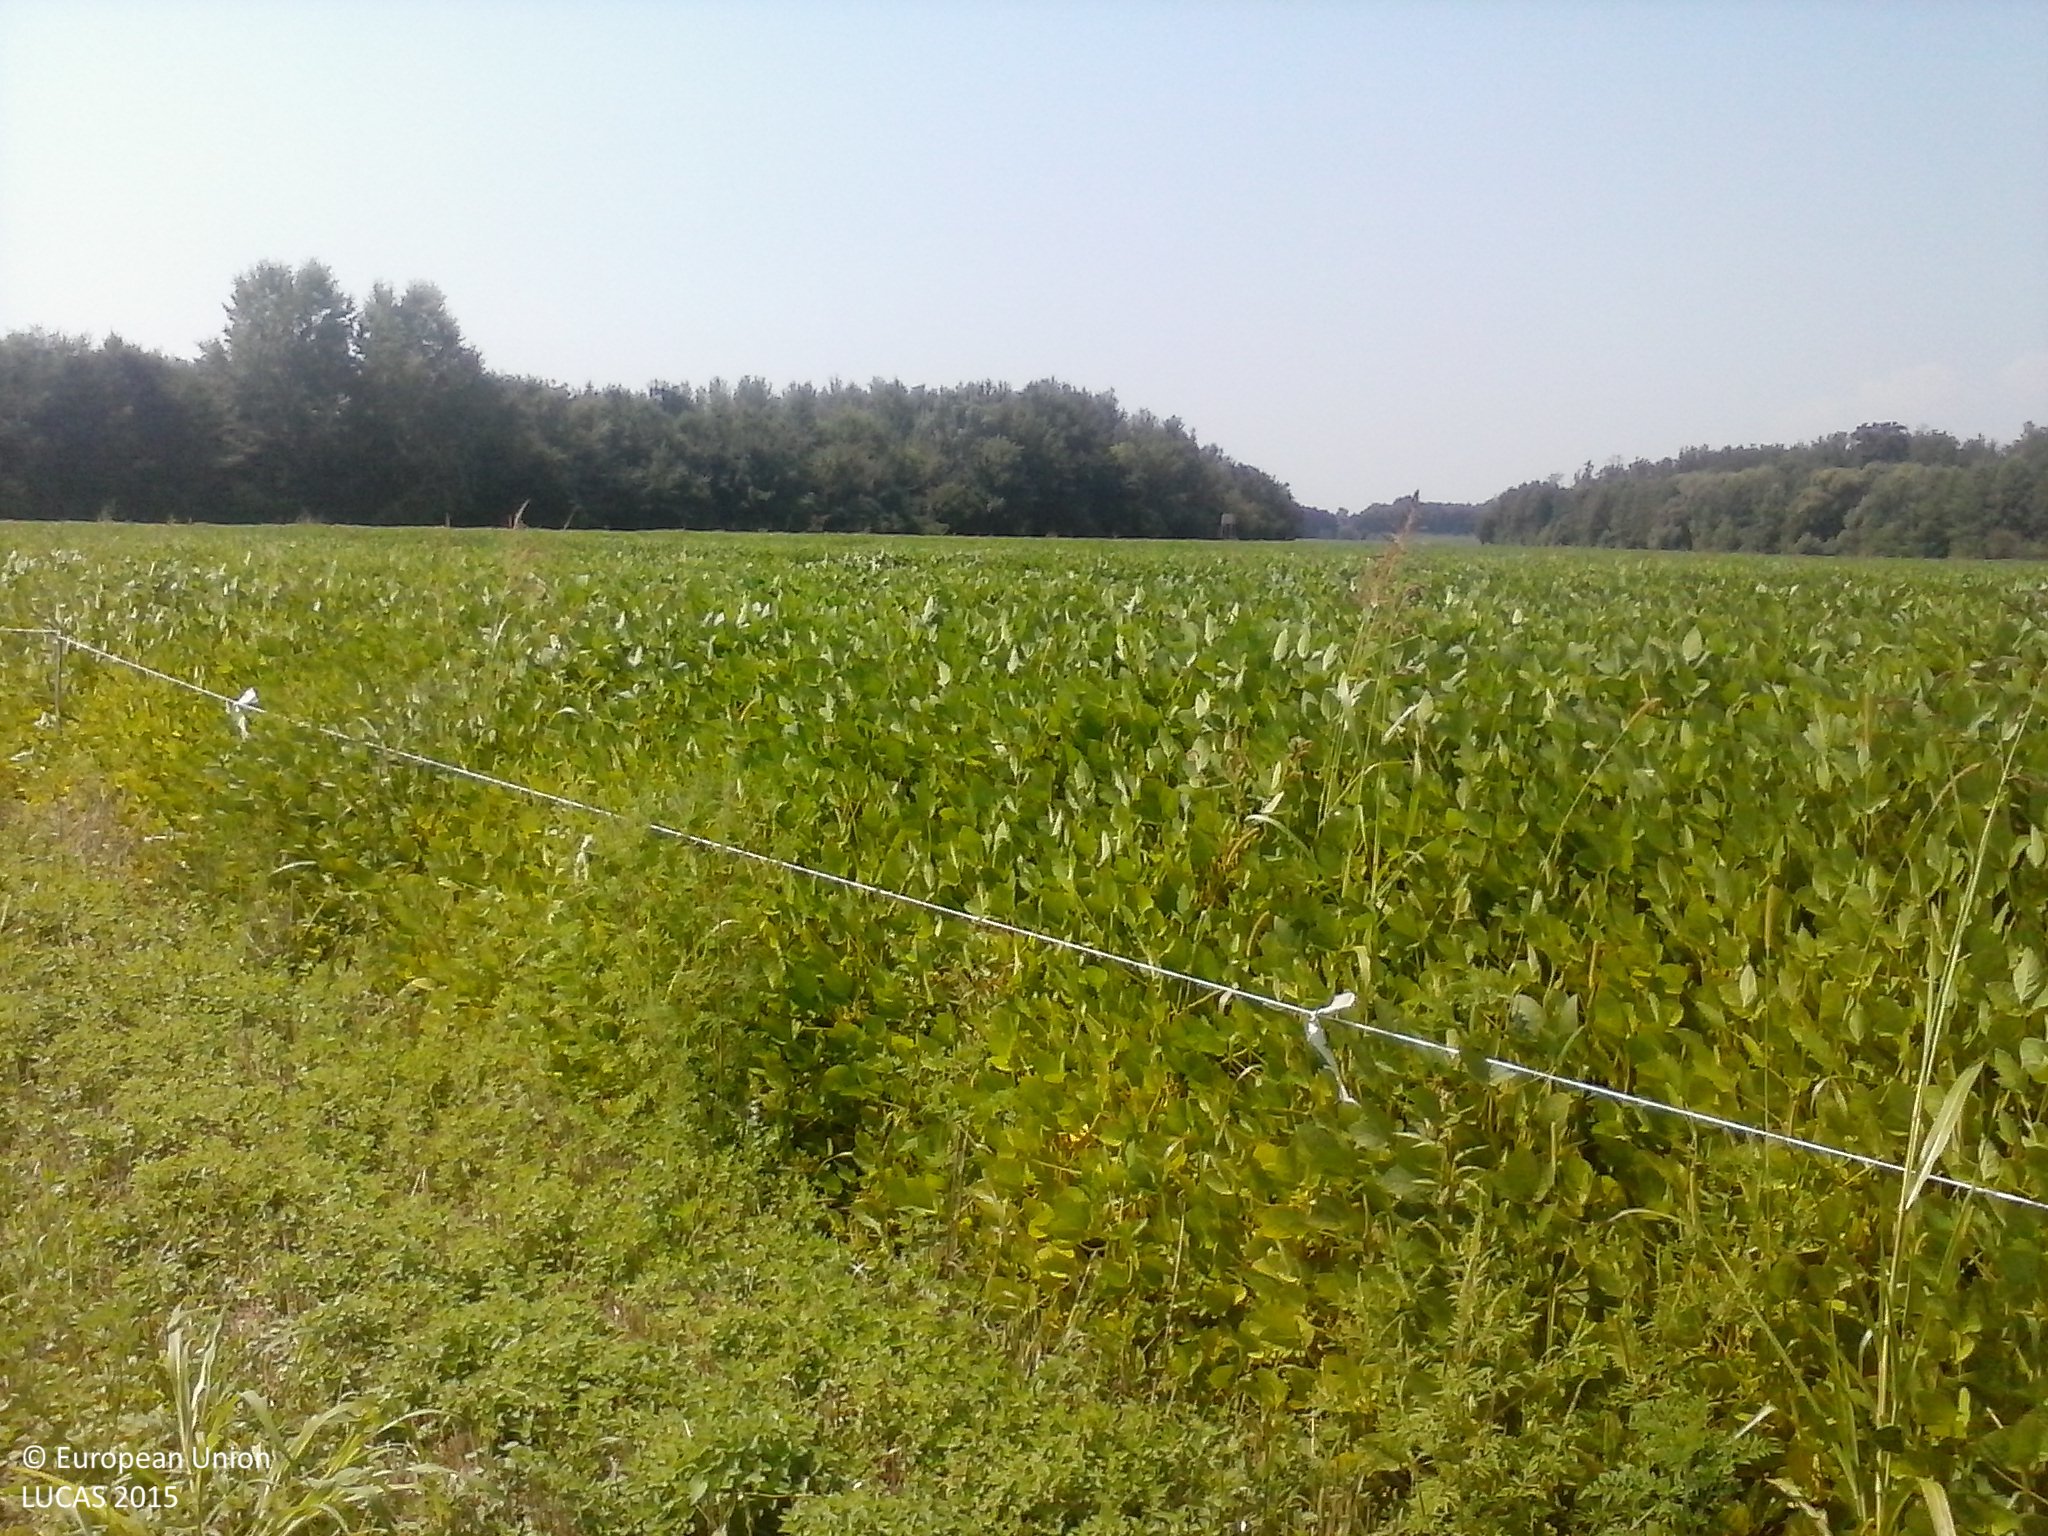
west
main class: Cropland
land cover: Common wheat
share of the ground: 10 - 25 %
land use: Agriculture (excluding fallow land and kitchen gardens)
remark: Harvested field
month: August
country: HU
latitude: 45.8239
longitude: 17.8948
